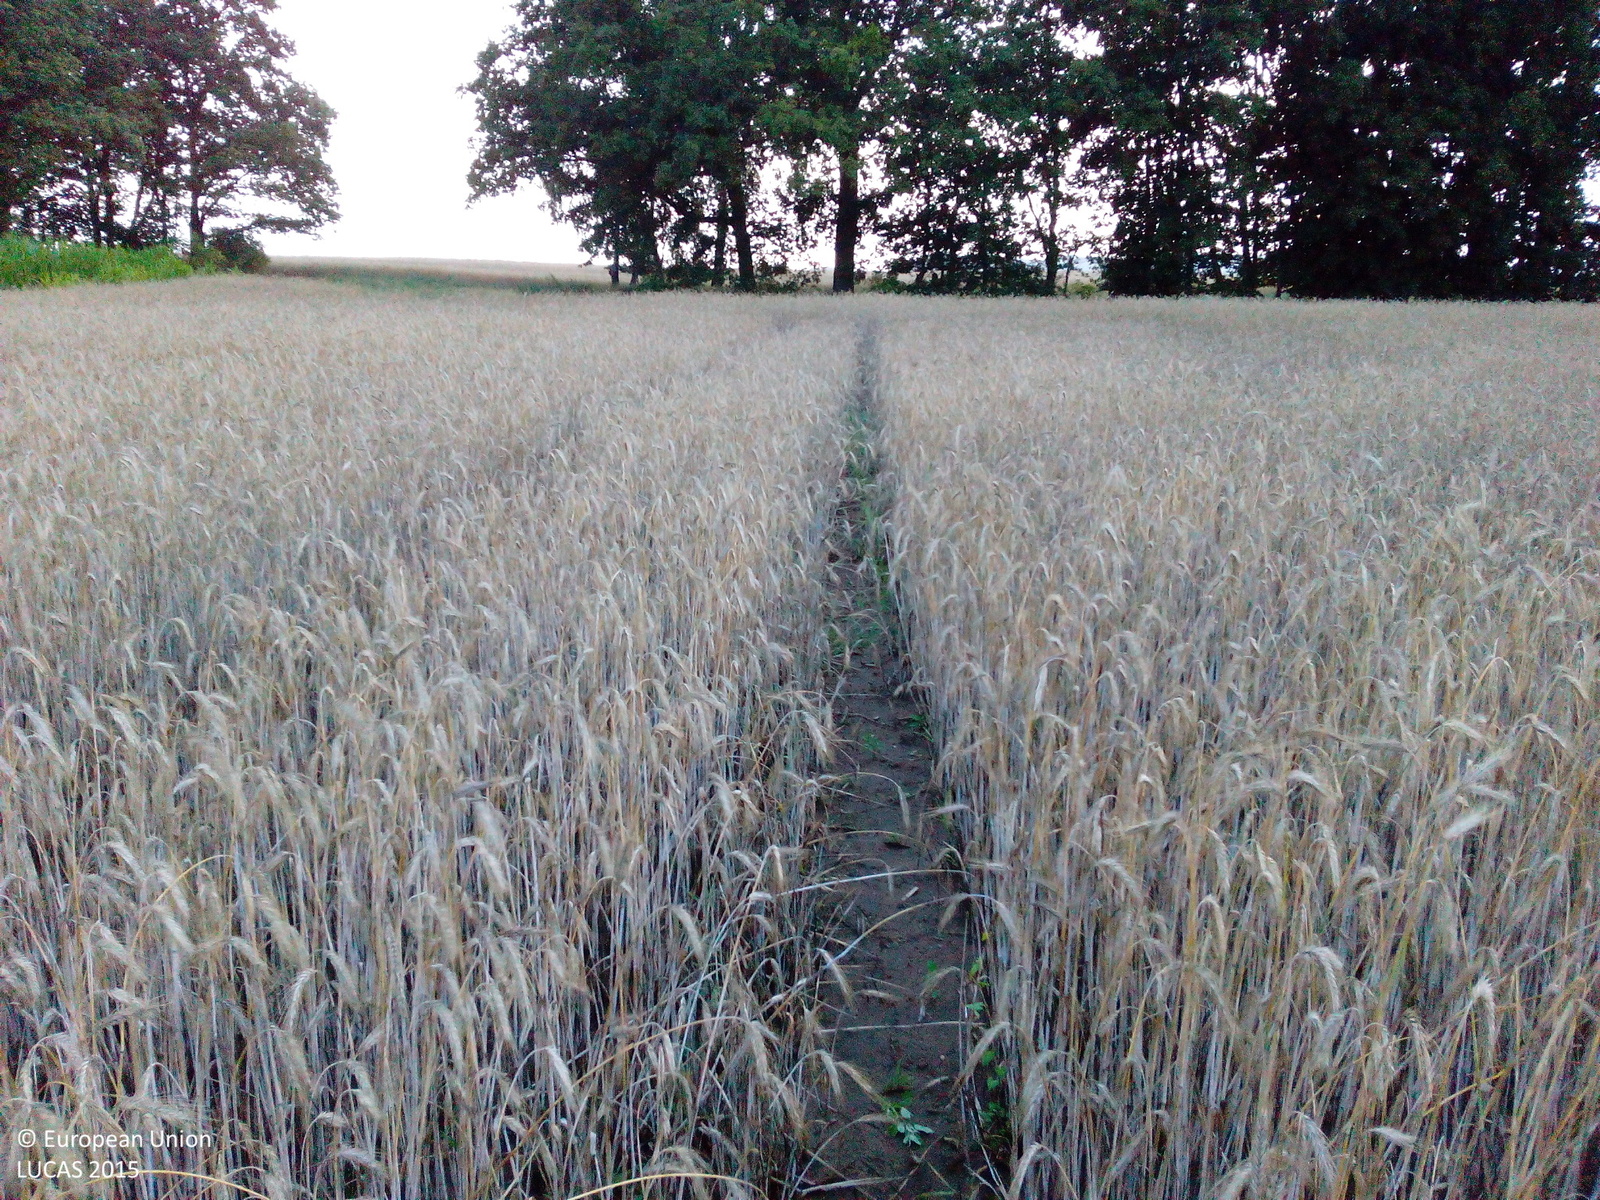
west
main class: Cropland
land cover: Rye
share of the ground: > 75 %
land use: Agriculture (excluding fallow land and kitchen gardens)
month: July
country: DE
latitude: 53.1617
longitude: 12.4373
